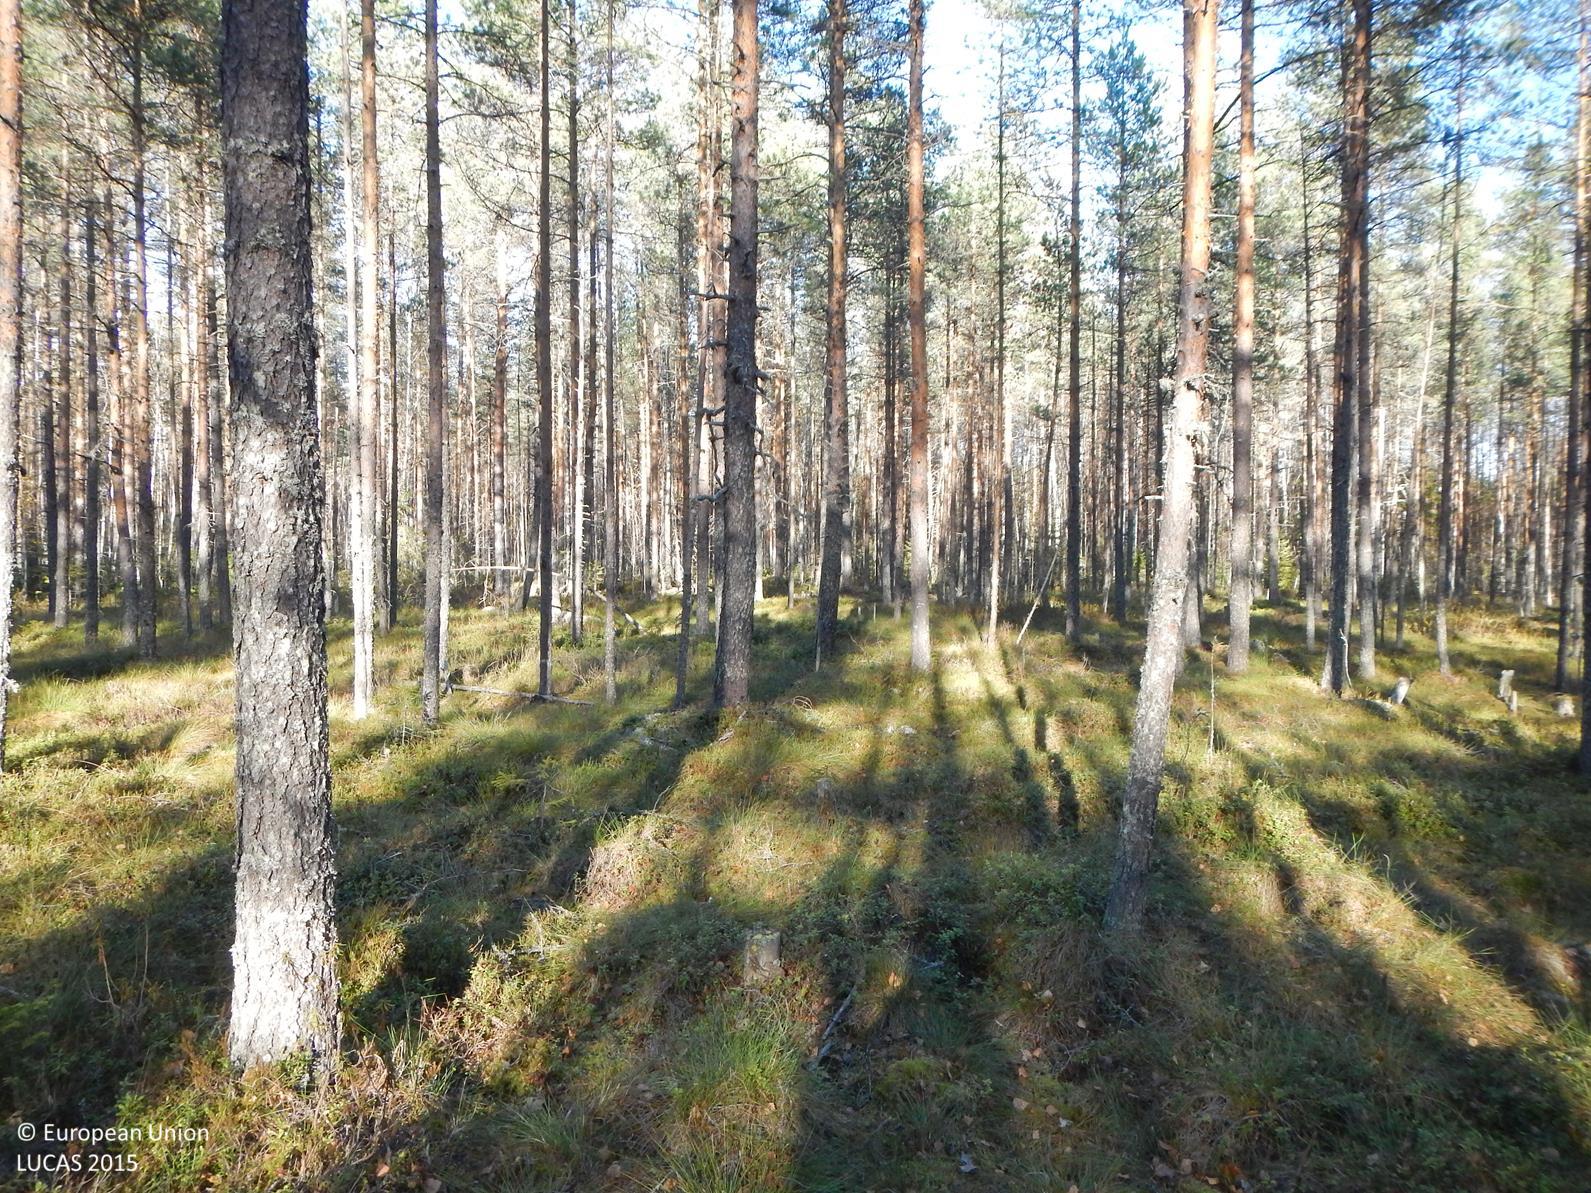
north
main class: Woodland
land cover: Pine dominated coniferous woodland
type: mire and swamp forests
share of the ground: 50 - 75 %
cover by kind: coniferous forest trees 60 %, shrubs 20 %, lichens and mosses 20 %
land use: Forestry
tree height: > 5 m
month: October
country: FI
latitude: 61.8844
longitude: 25.9357
